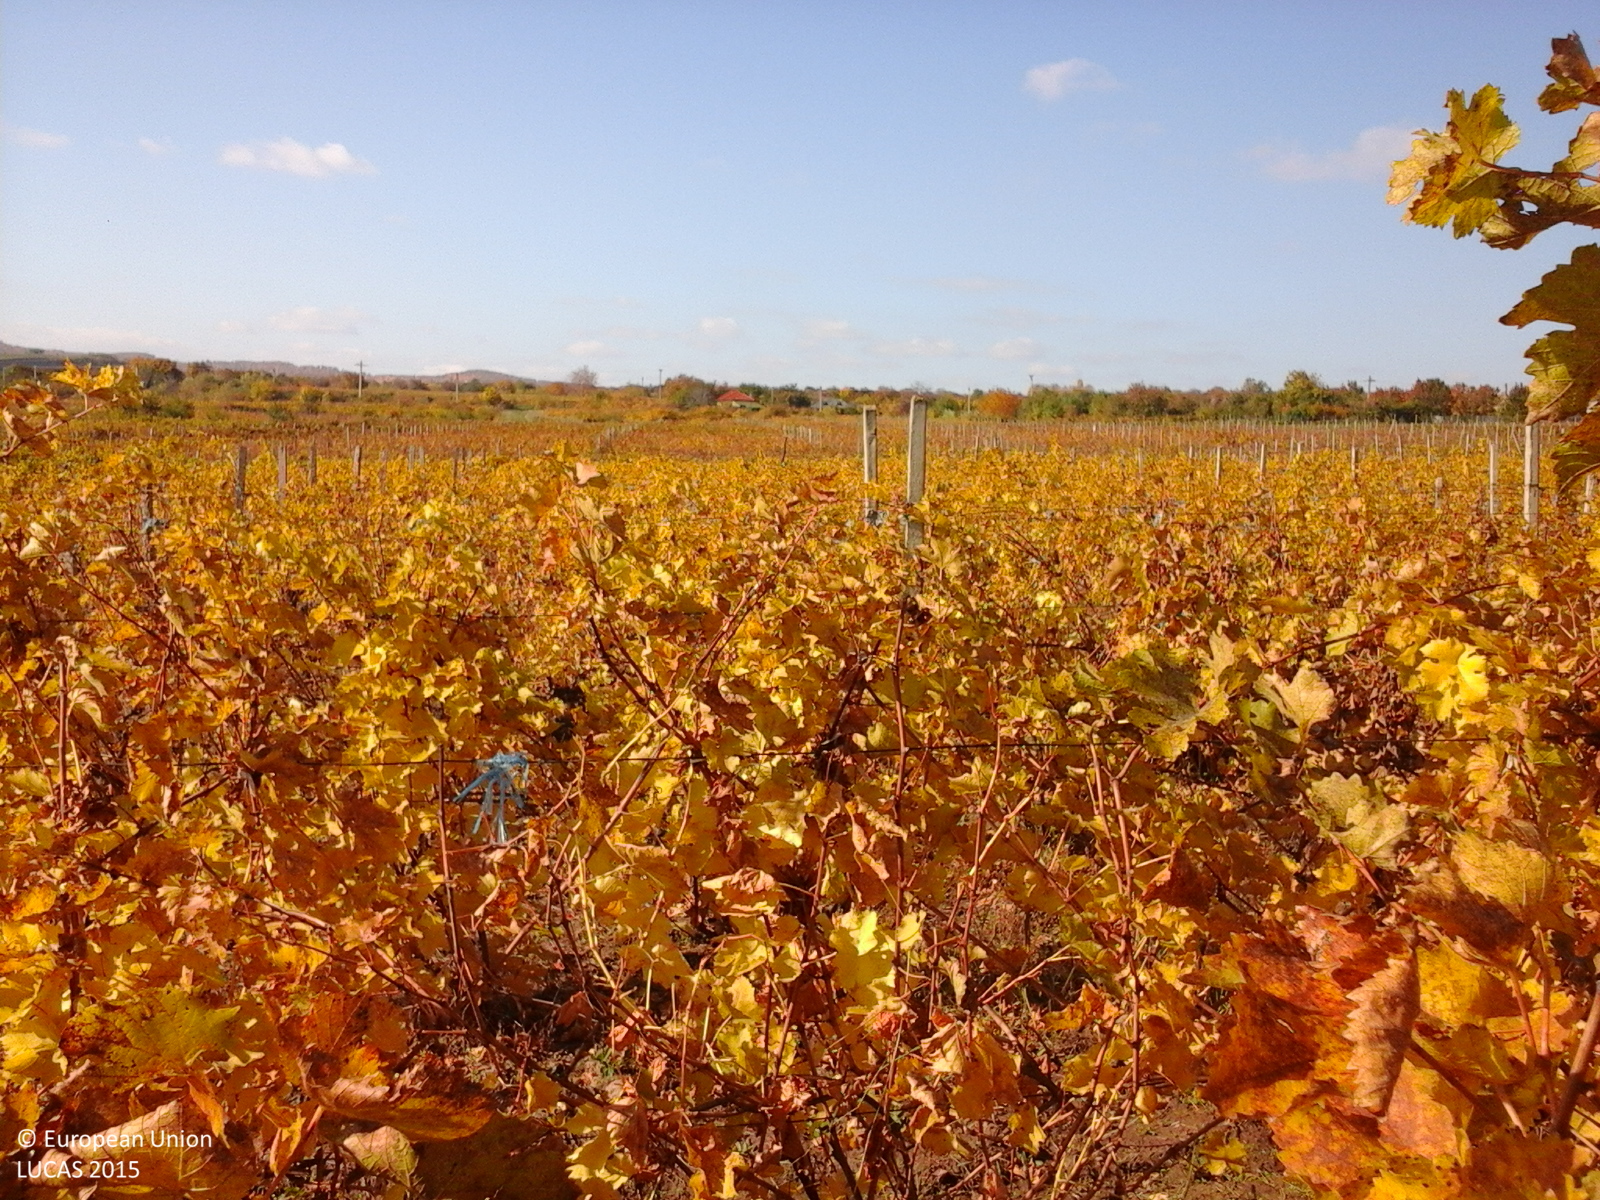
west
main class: Cropland
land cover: Vineyards
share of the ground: 50 - 75 %
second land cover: Other bare soil
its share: > 75 %
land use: Agriculture (excluding fallow land and kitchen gardens)
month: October
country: RO
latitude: 45.6296
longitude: 27.0610
